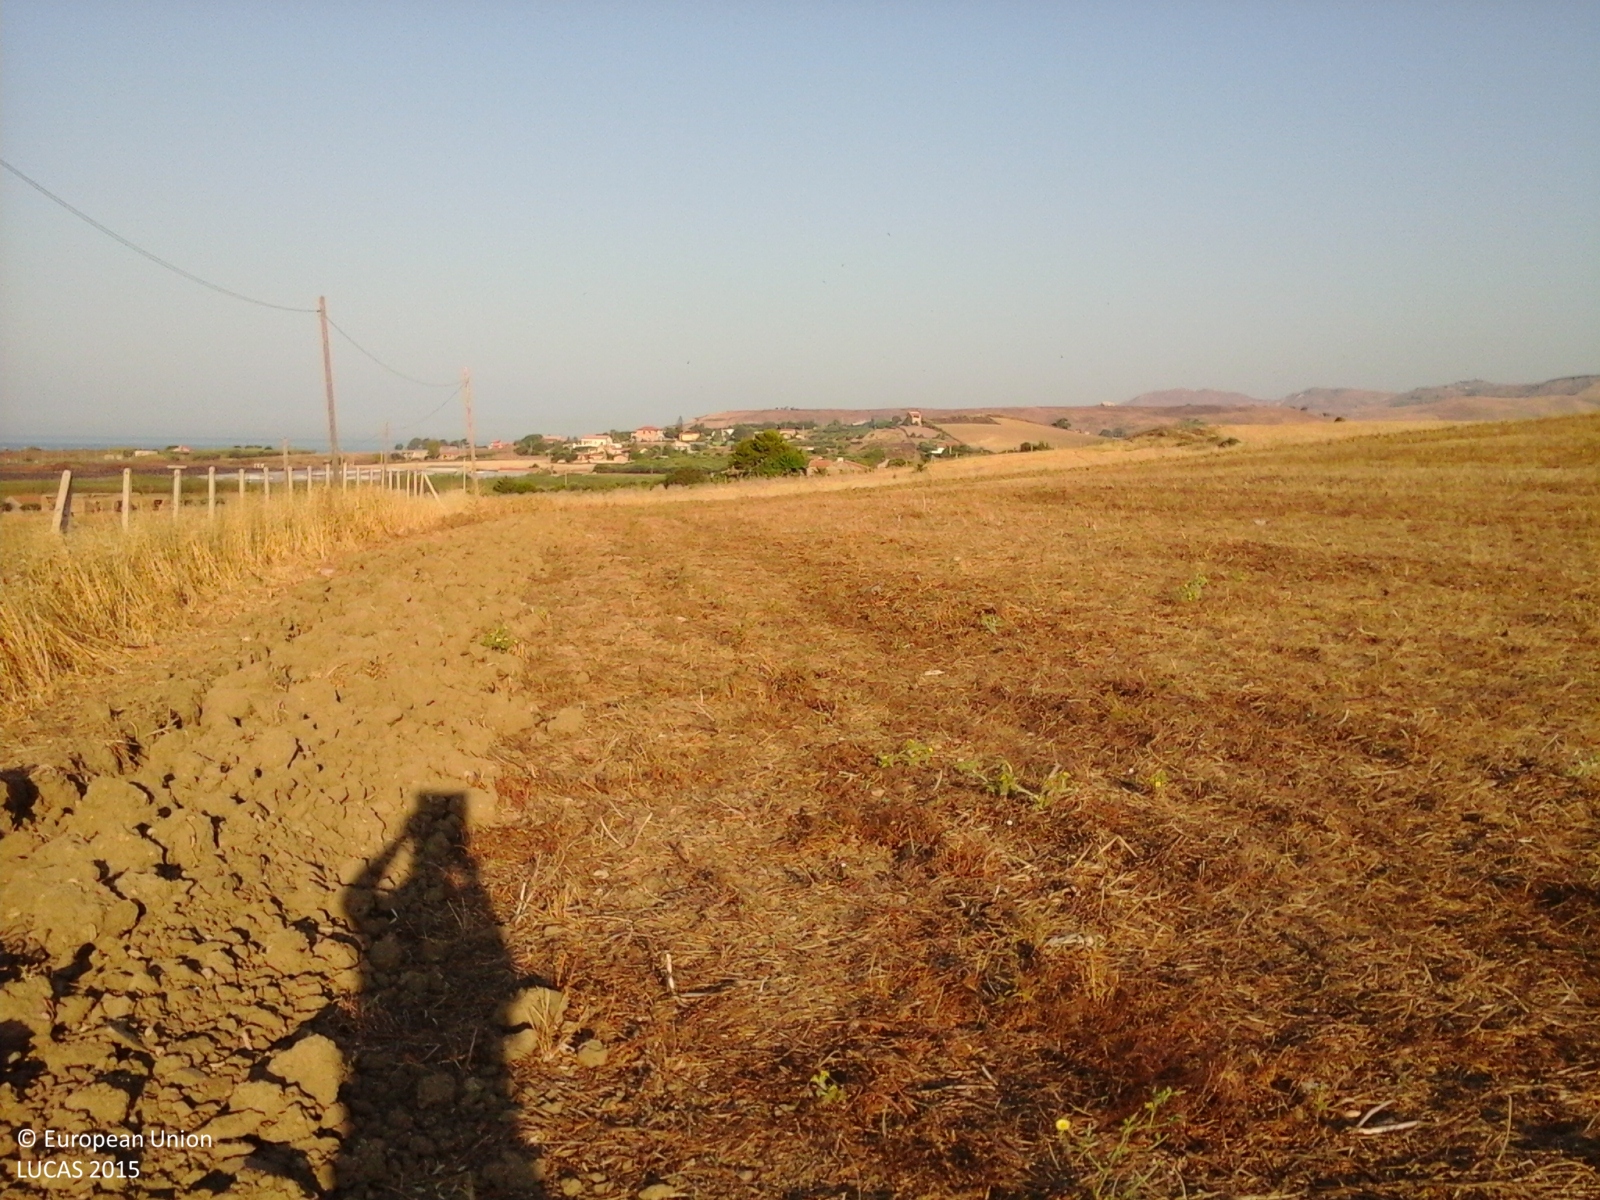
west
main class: Cropland
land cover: Other leguminous and mixtures for fodder
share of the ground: > 75 %
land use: Agriculture (excluding fallow land and kitchen gardens)
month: July
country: IT
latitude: 37.1138
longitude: 14.0978
